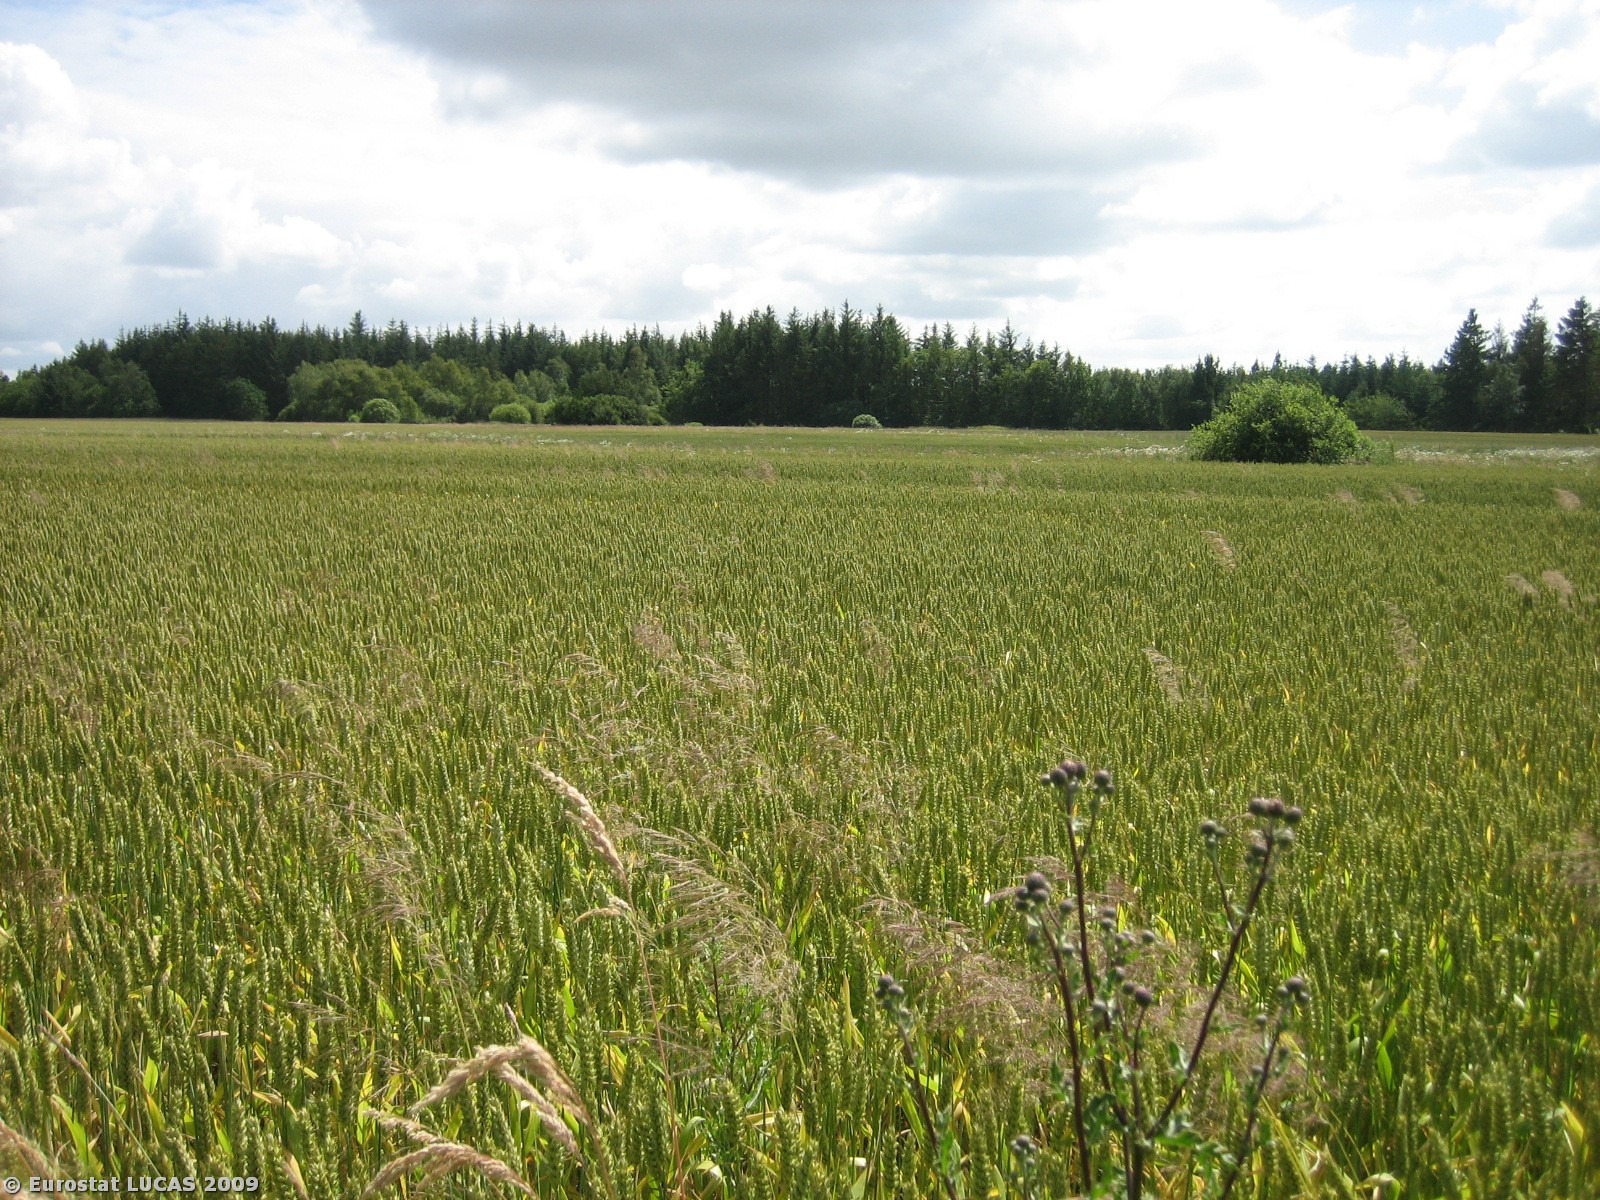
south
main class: Cropland
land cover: Common wheat
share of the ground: > 75 %
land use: Agriculture (excluding fallow land and kitchen gardens)
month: July
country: DK
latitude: 55.9098
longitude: 8.5457
